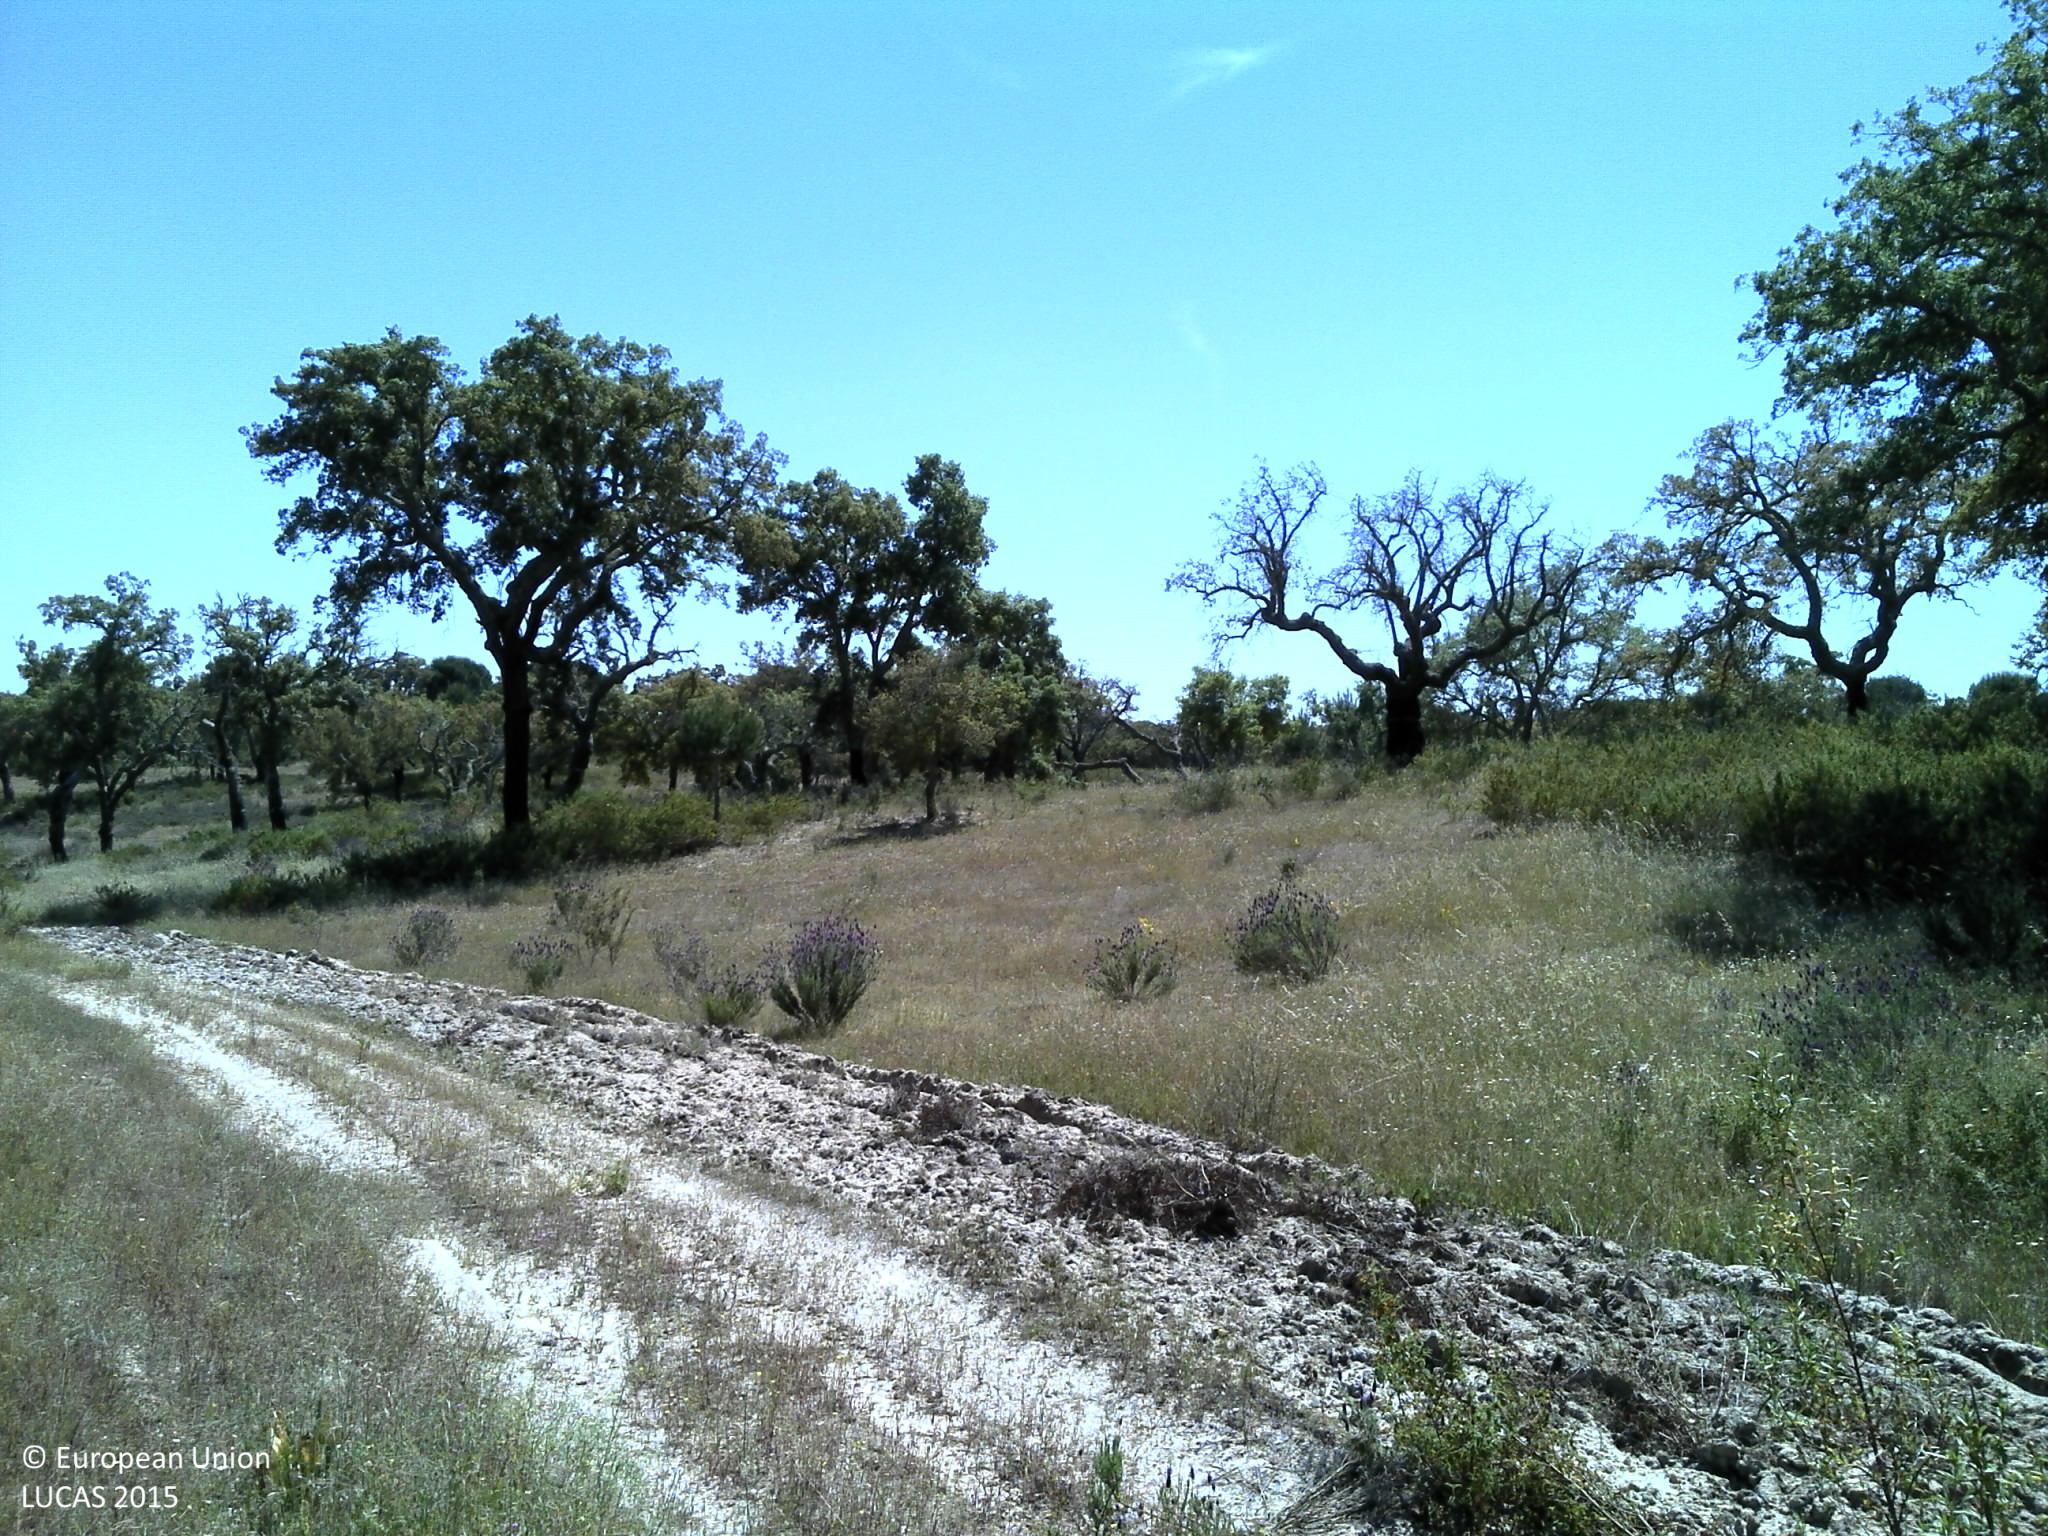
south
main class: Woodland
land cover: Broadleaved woodland
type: broadleaved evergreen forest
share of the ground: 10 - 25 %
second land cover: Grassland without tree/shrub cover
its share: 10 - 25 %
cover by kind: unconsolidated bare surface 55 %, broadleaved forest trees 15 %, shrubs 15 %, herbaceous plants 15 %
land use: Forestry
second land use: Agriculture (excluding fallow land and kitchen gardens)
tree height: > 5 m
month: May
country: PT
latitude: 39.0025
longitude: -8.1480
